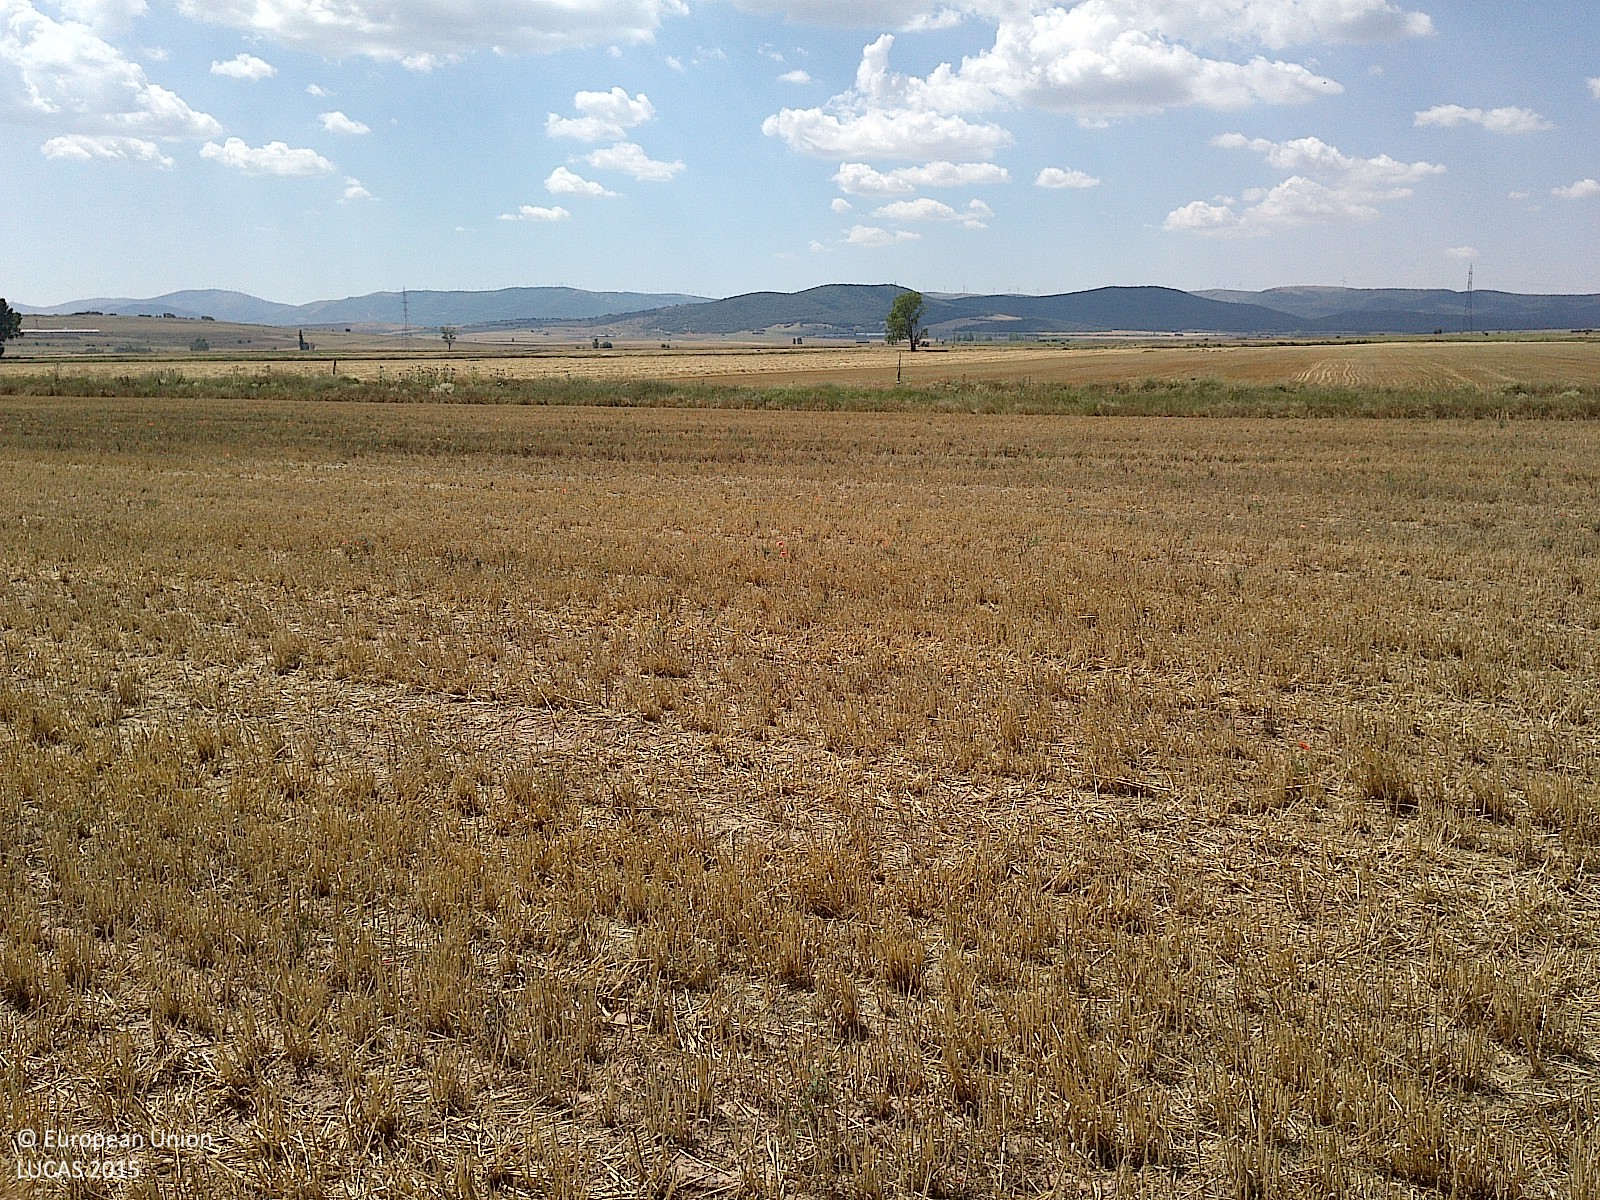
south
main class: Cropland
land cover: Barley
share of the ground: < 10 %
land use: Agriculture (excluding fallow land and kitchen gardens)
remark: Harvested field
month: July
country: ES
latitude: 41.8624
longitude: -2.0207
